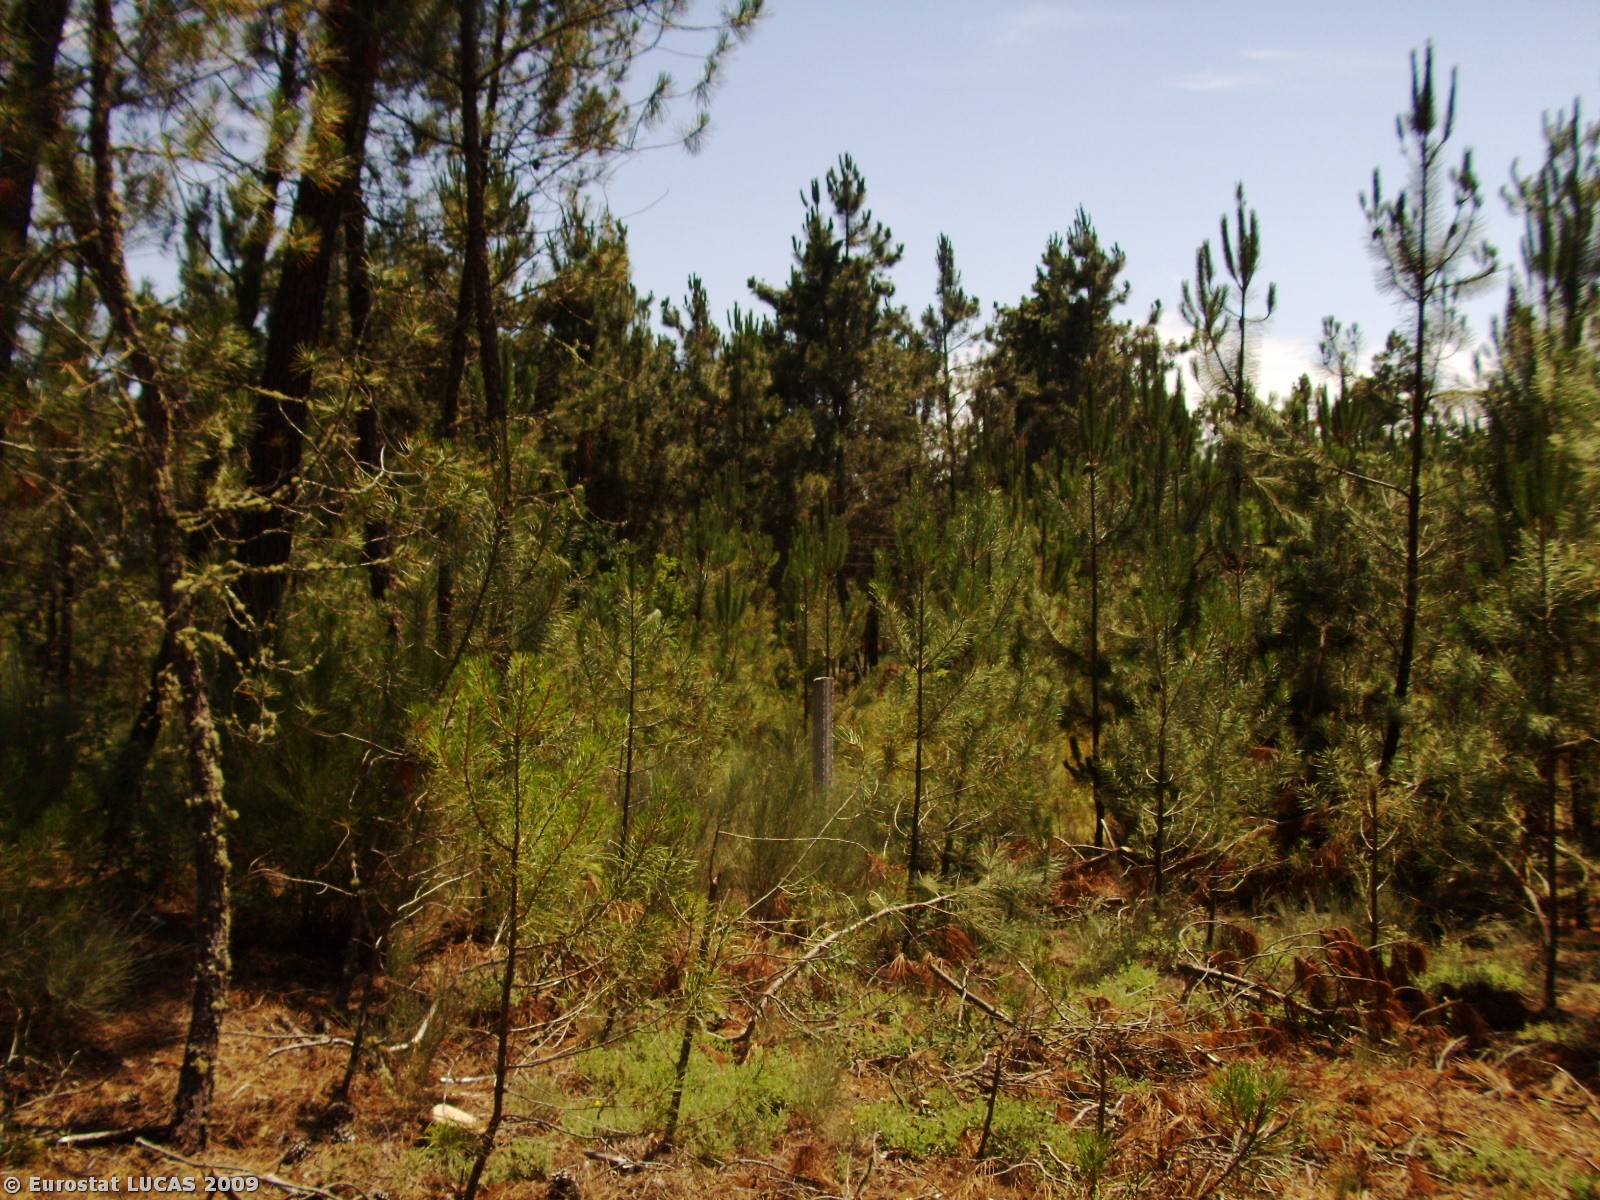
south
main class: Woodland
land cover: Coniferous woodland
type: coniferous forest of the mediterranean region
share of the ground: 50 - 75 %
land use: Forestry
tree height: > 5 m
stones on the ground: < 10 %
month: July
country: PT
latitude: 40.8563
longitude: -7.7150
